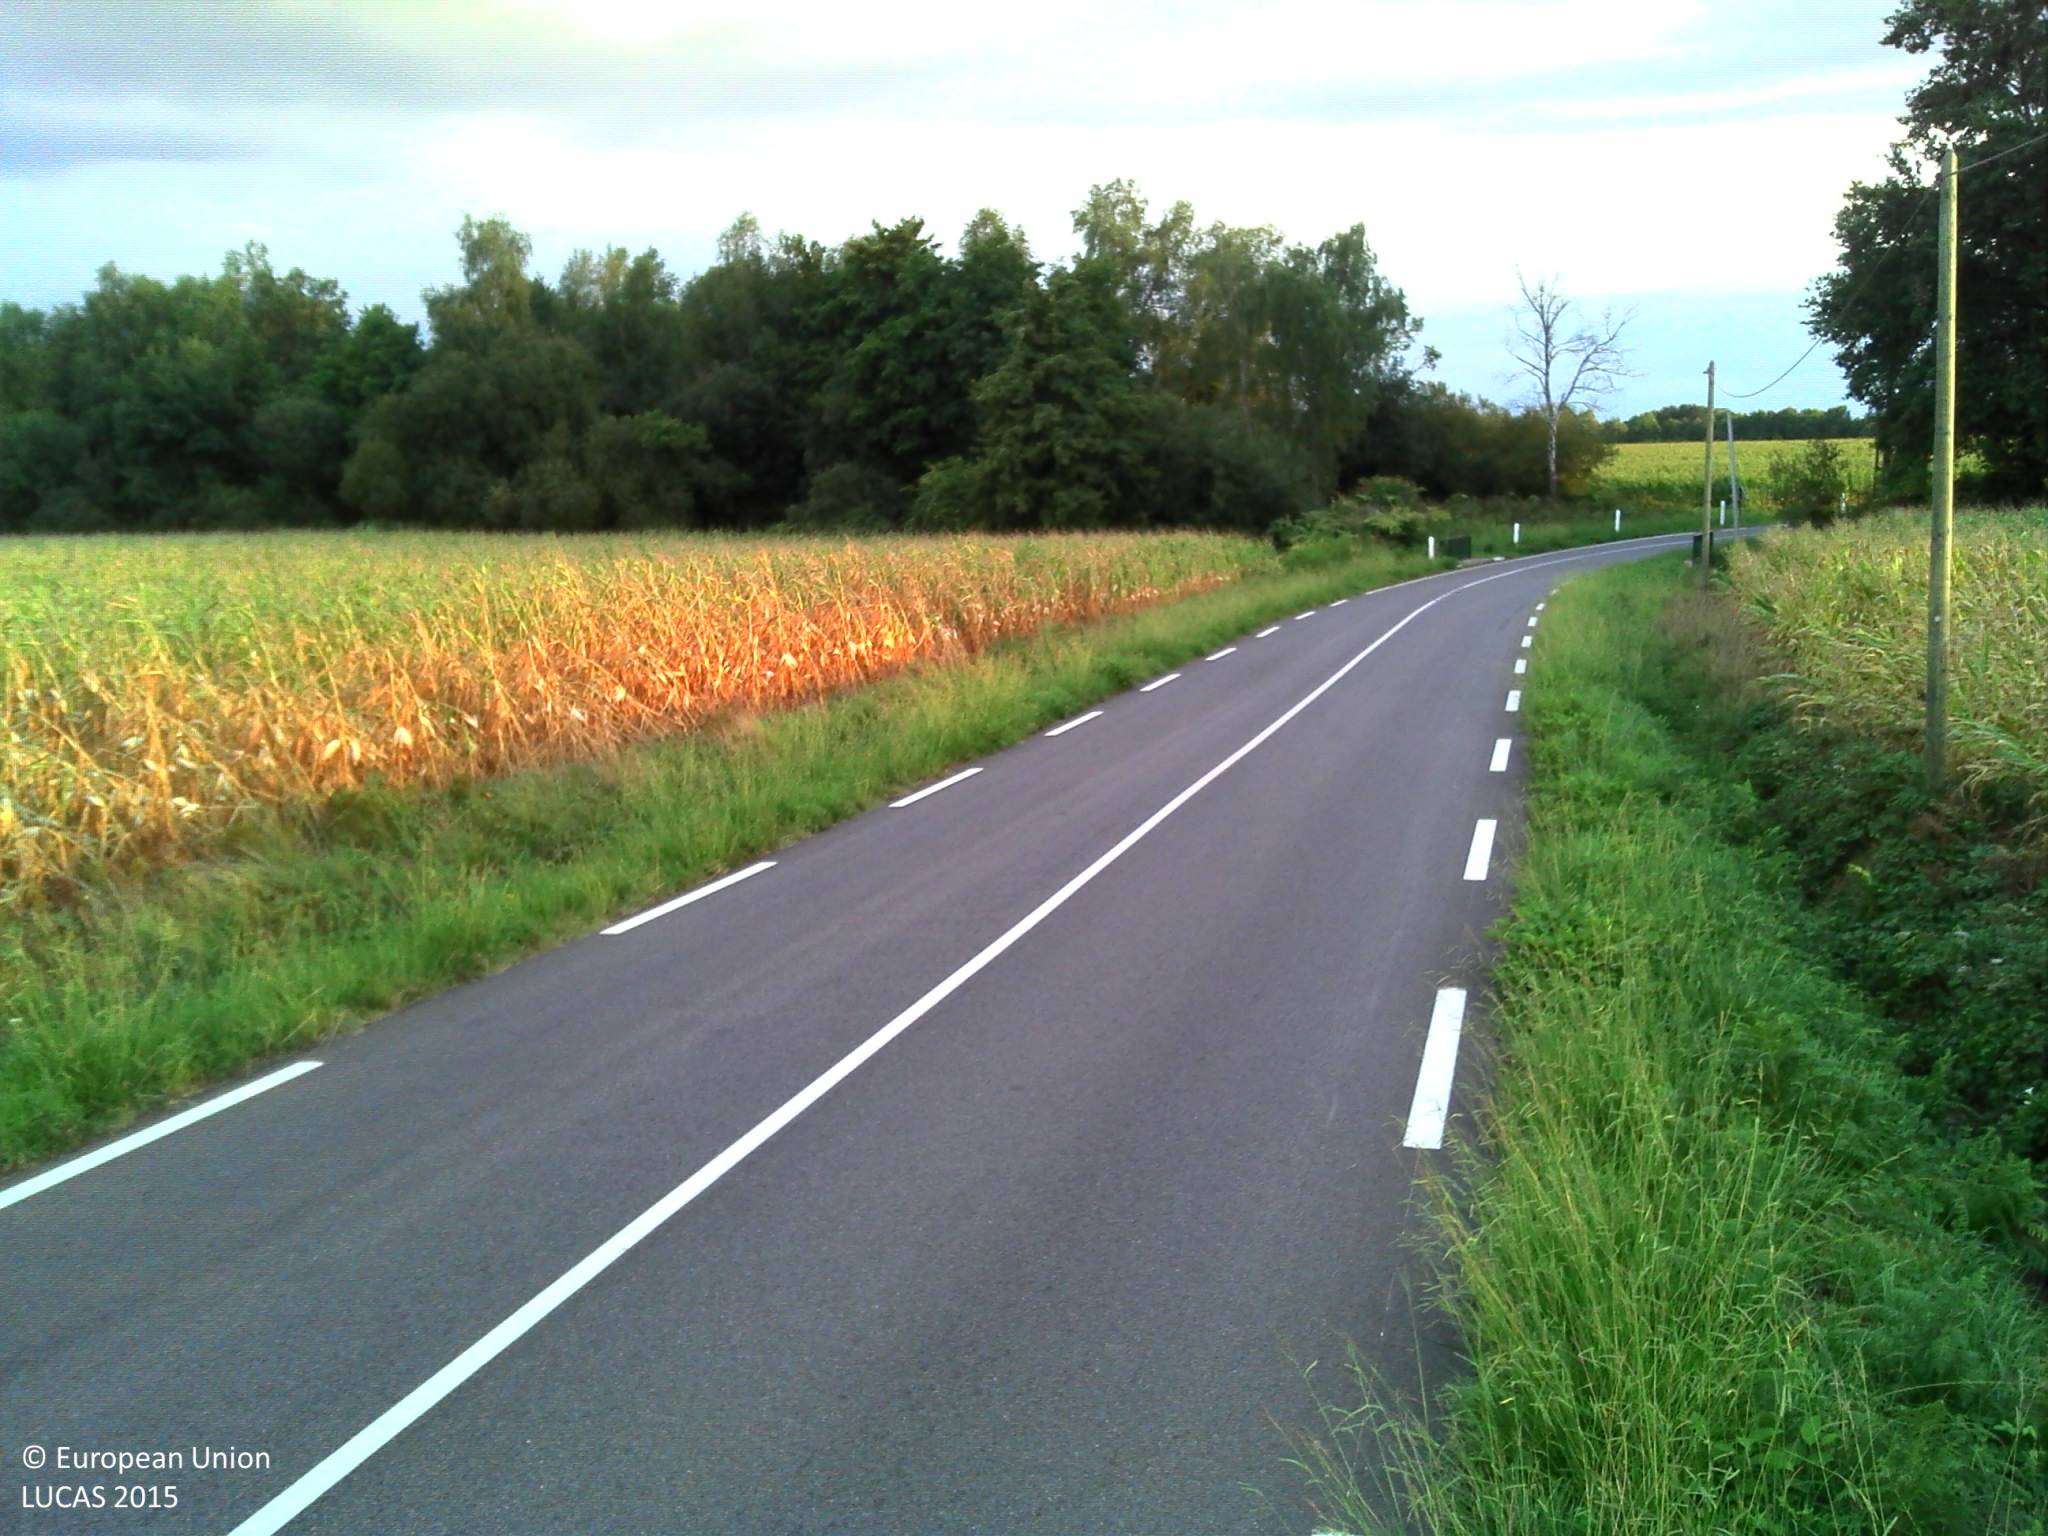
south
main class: Cropland
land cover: Maize
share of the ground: > 75 %
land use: Agriculture (excluding fallow land and kitchen gardens)
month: September
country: FR
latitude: 43.3864
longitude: -0.4389
